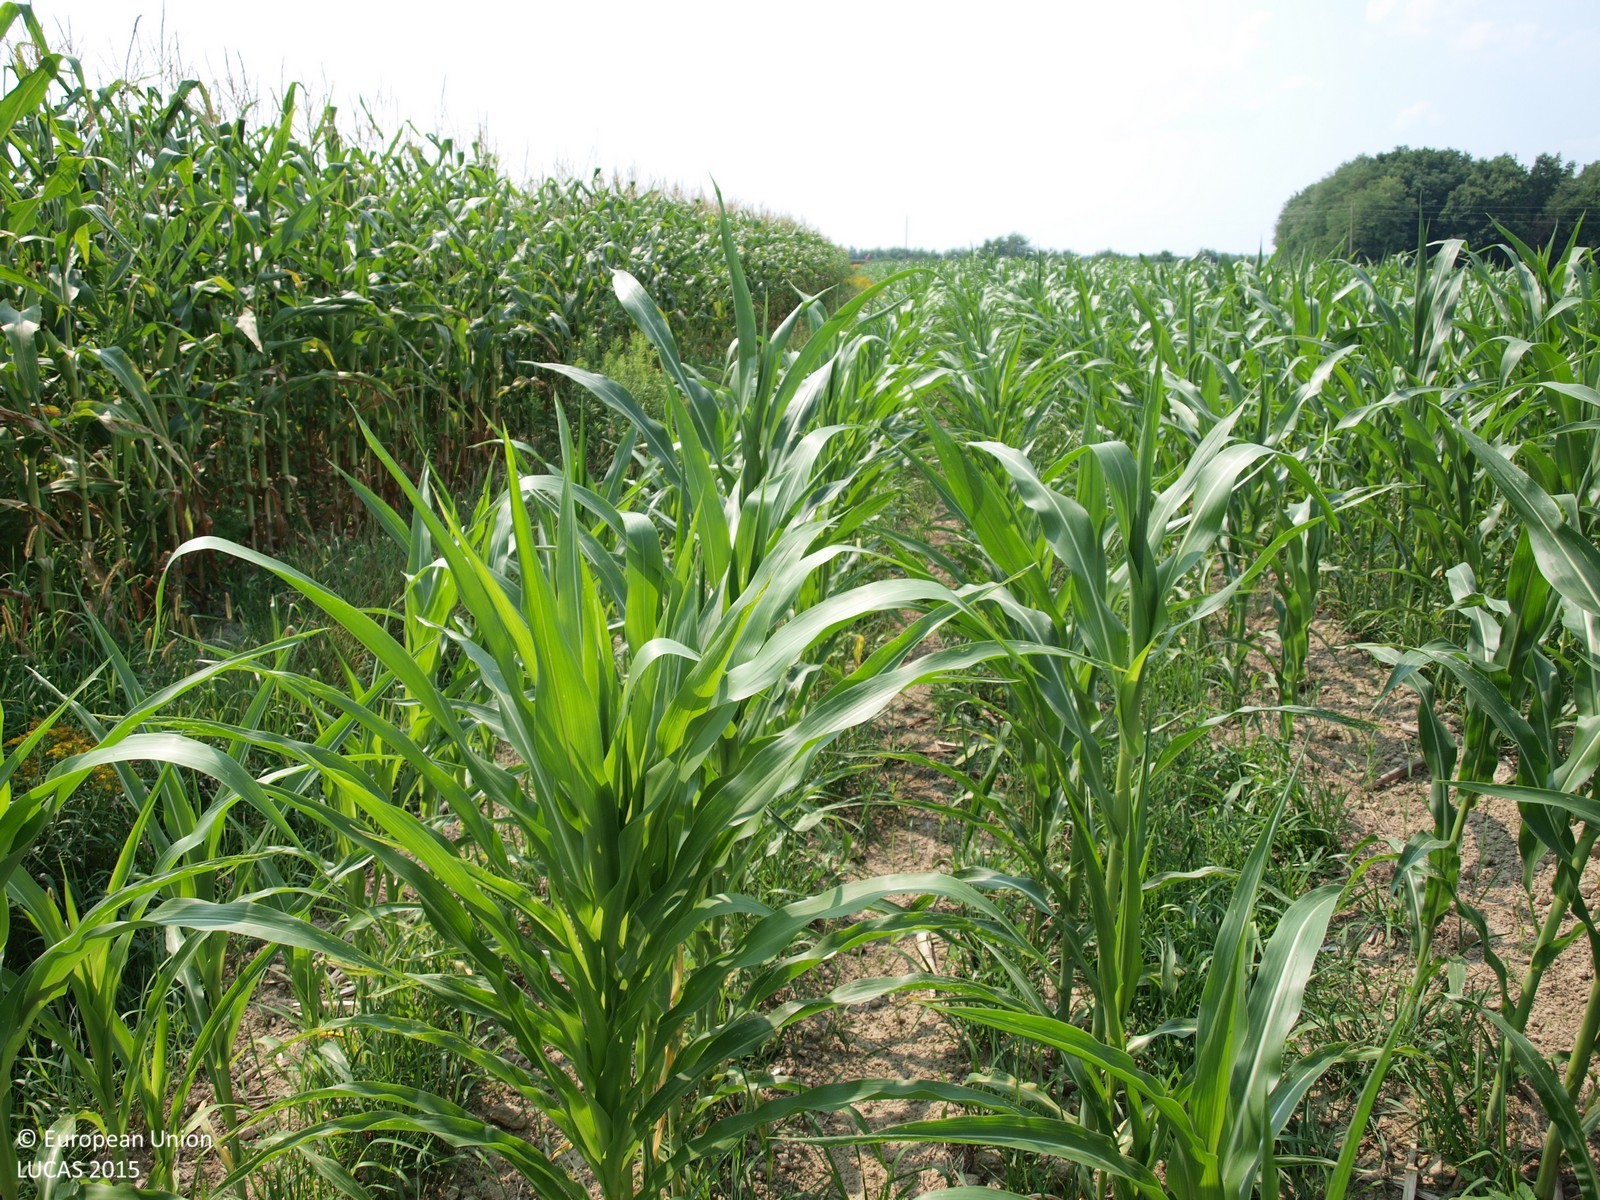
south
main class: Cropland
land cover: Maize
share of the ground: > 75 %
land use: Agriculture (excluding fallow land and kitchen gardens)
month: August
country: HR
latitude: 45.8898
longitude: 16.3781
